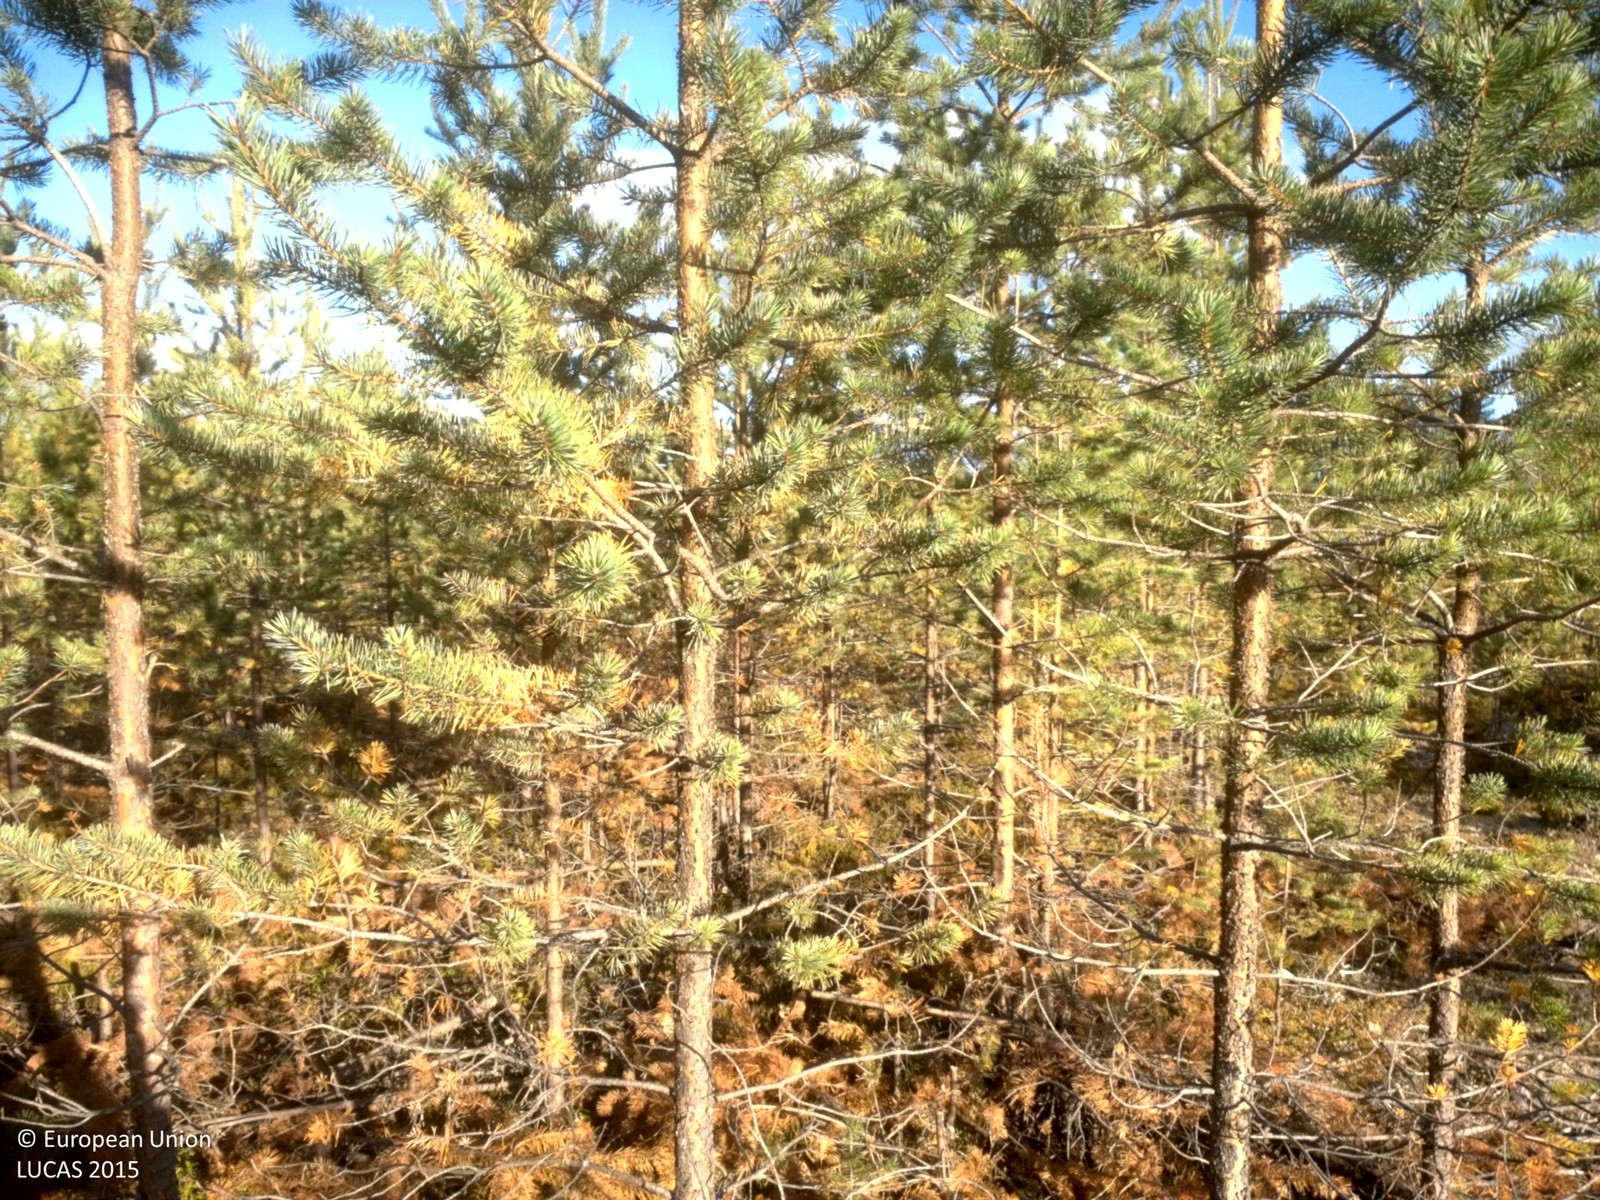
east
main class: Woodland
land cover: Pine dominated coniferous woodland
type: boreal forest
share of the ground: 50 - 75 %
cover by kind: coniferous forest trees 65 %, lichens and mosses 25 %, shrubs 10 %
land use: Forestry
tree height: < 5 m
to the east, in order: Pine dominated coniferous woodland
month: September
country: SE
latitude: 64.4355
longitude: 18.9633
